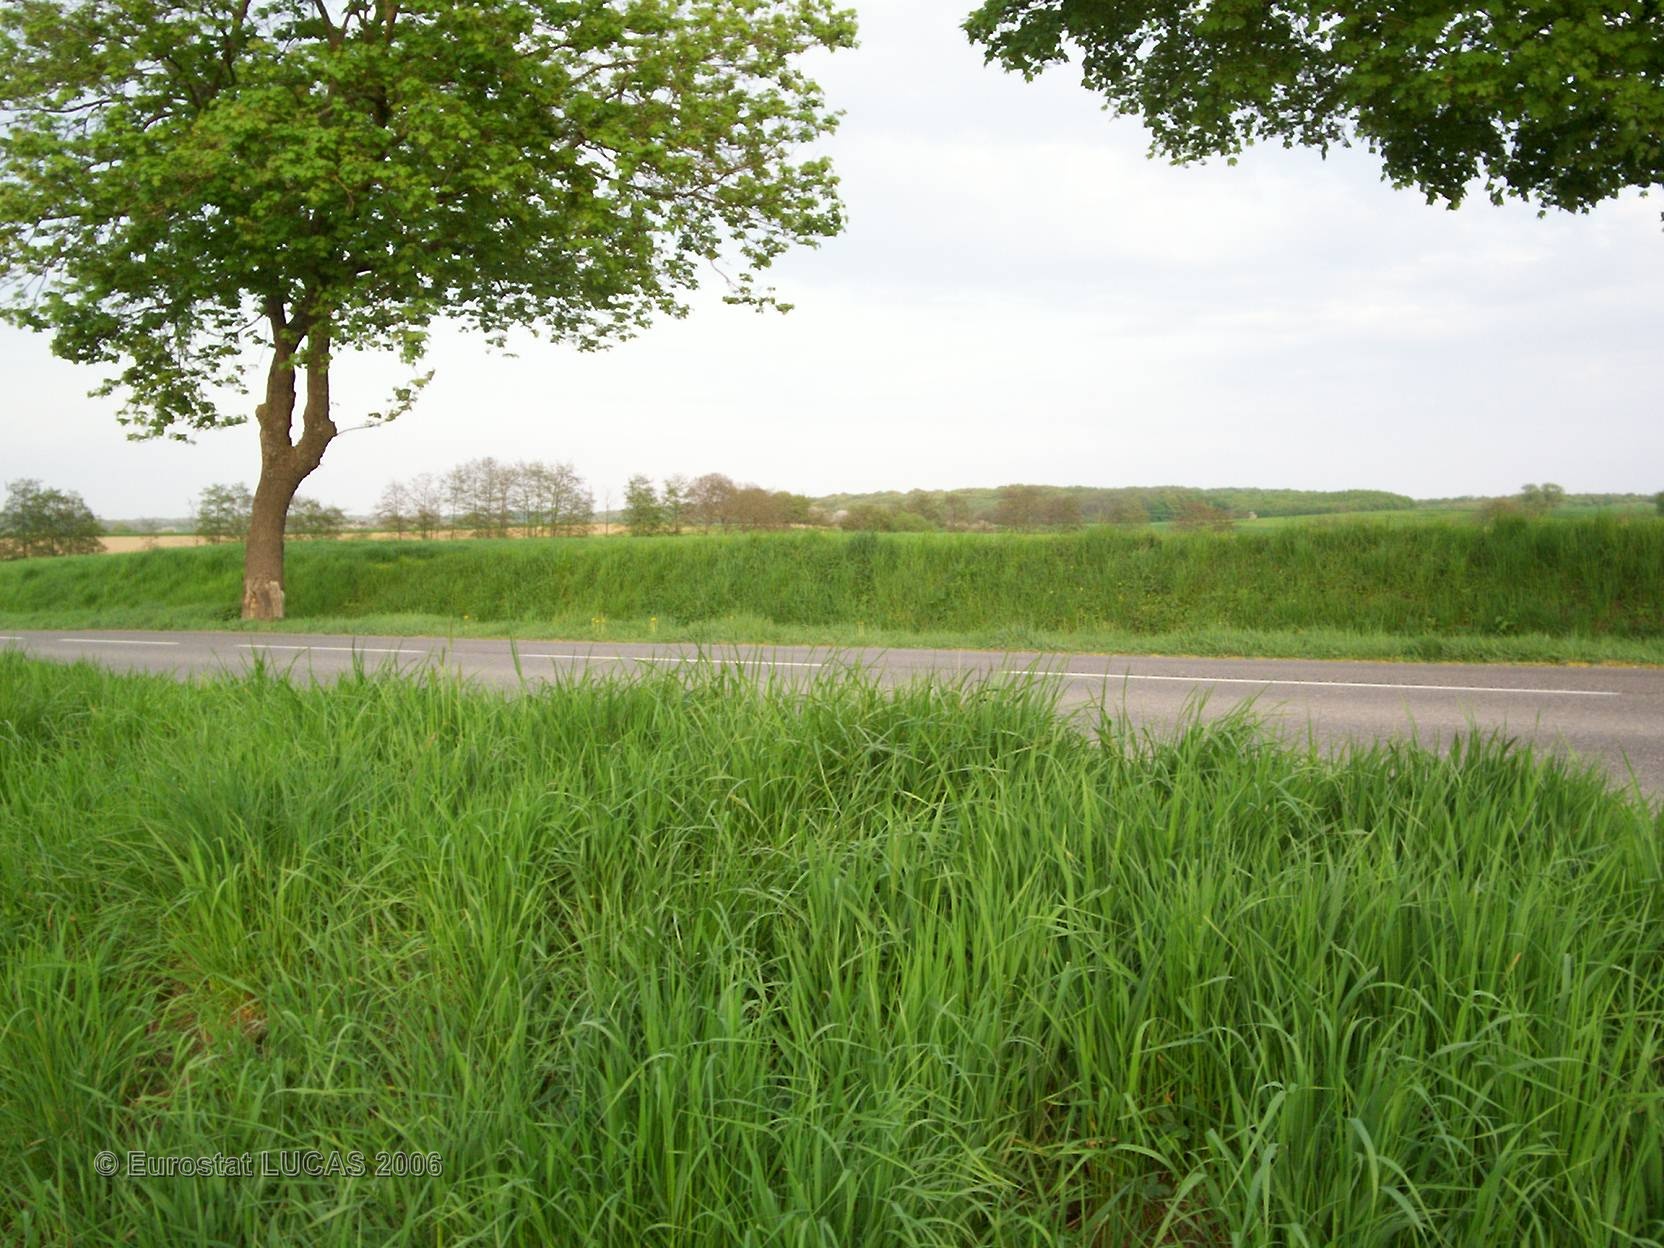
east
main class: Cropland
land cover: Maize
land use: Agriculture (excluding fallow land and kitchen gardens)
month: May
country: FR
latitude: 47.6462
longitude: 7.1395
